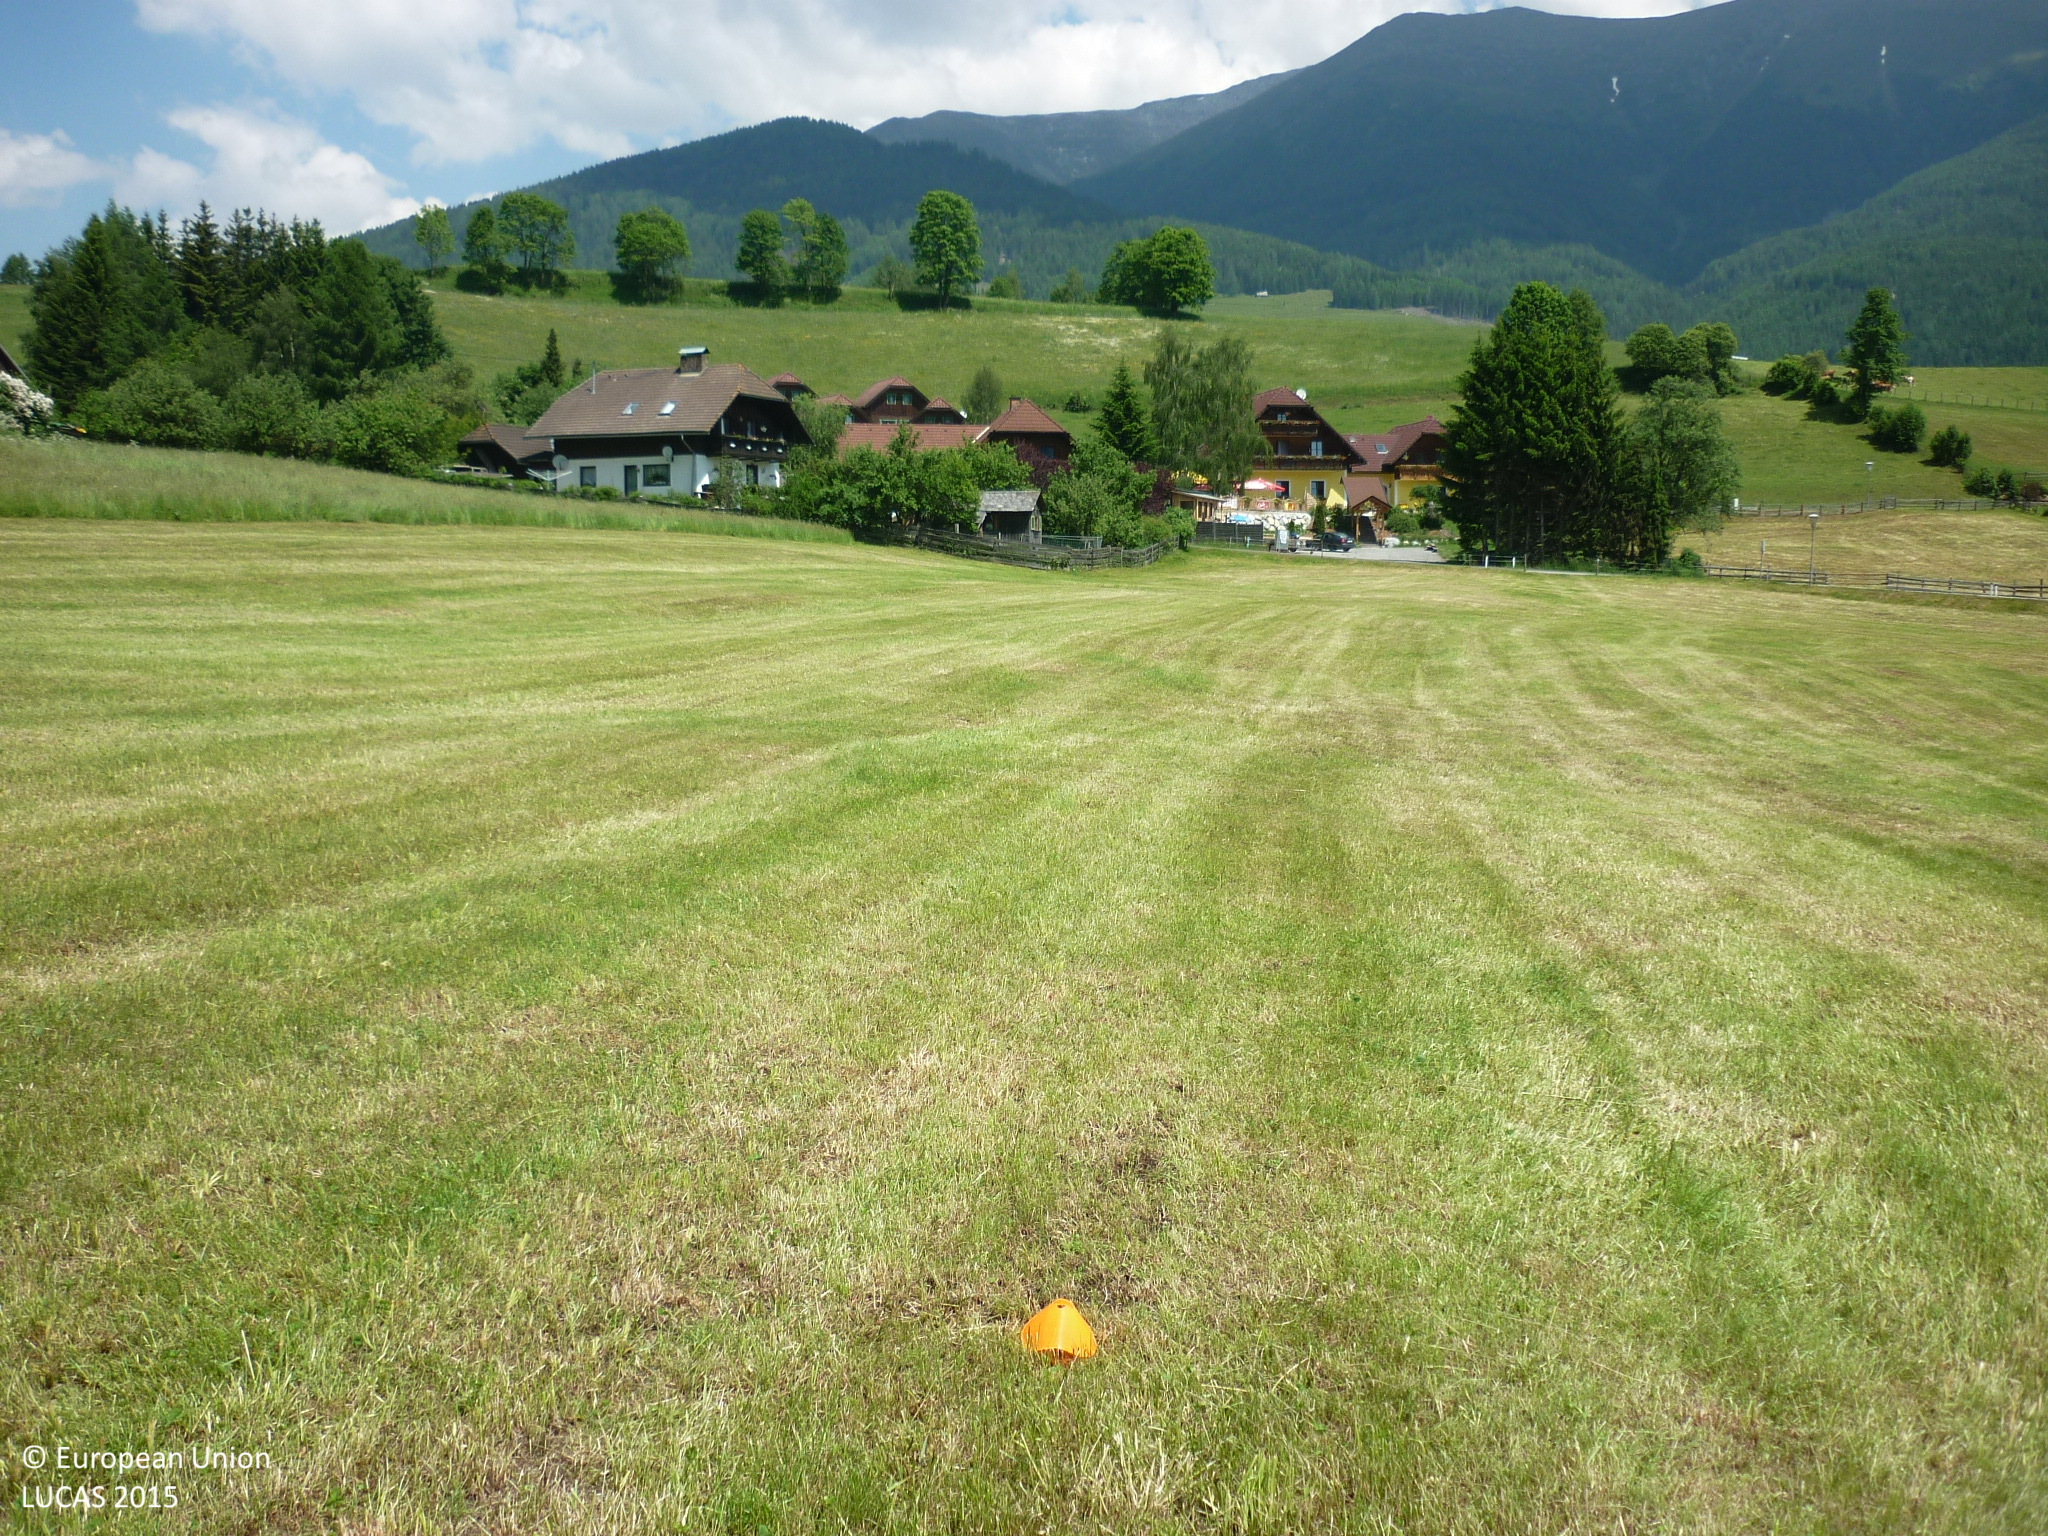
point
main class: Grassland
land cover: Grassland without tree/shrub cover
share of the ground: > 75 %
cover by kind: herbaceous plants 100 %
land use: Agriculture (excluding fallow land and kitchen gardens)
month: June
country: AT
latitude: 47.1780
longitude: 13.9962
